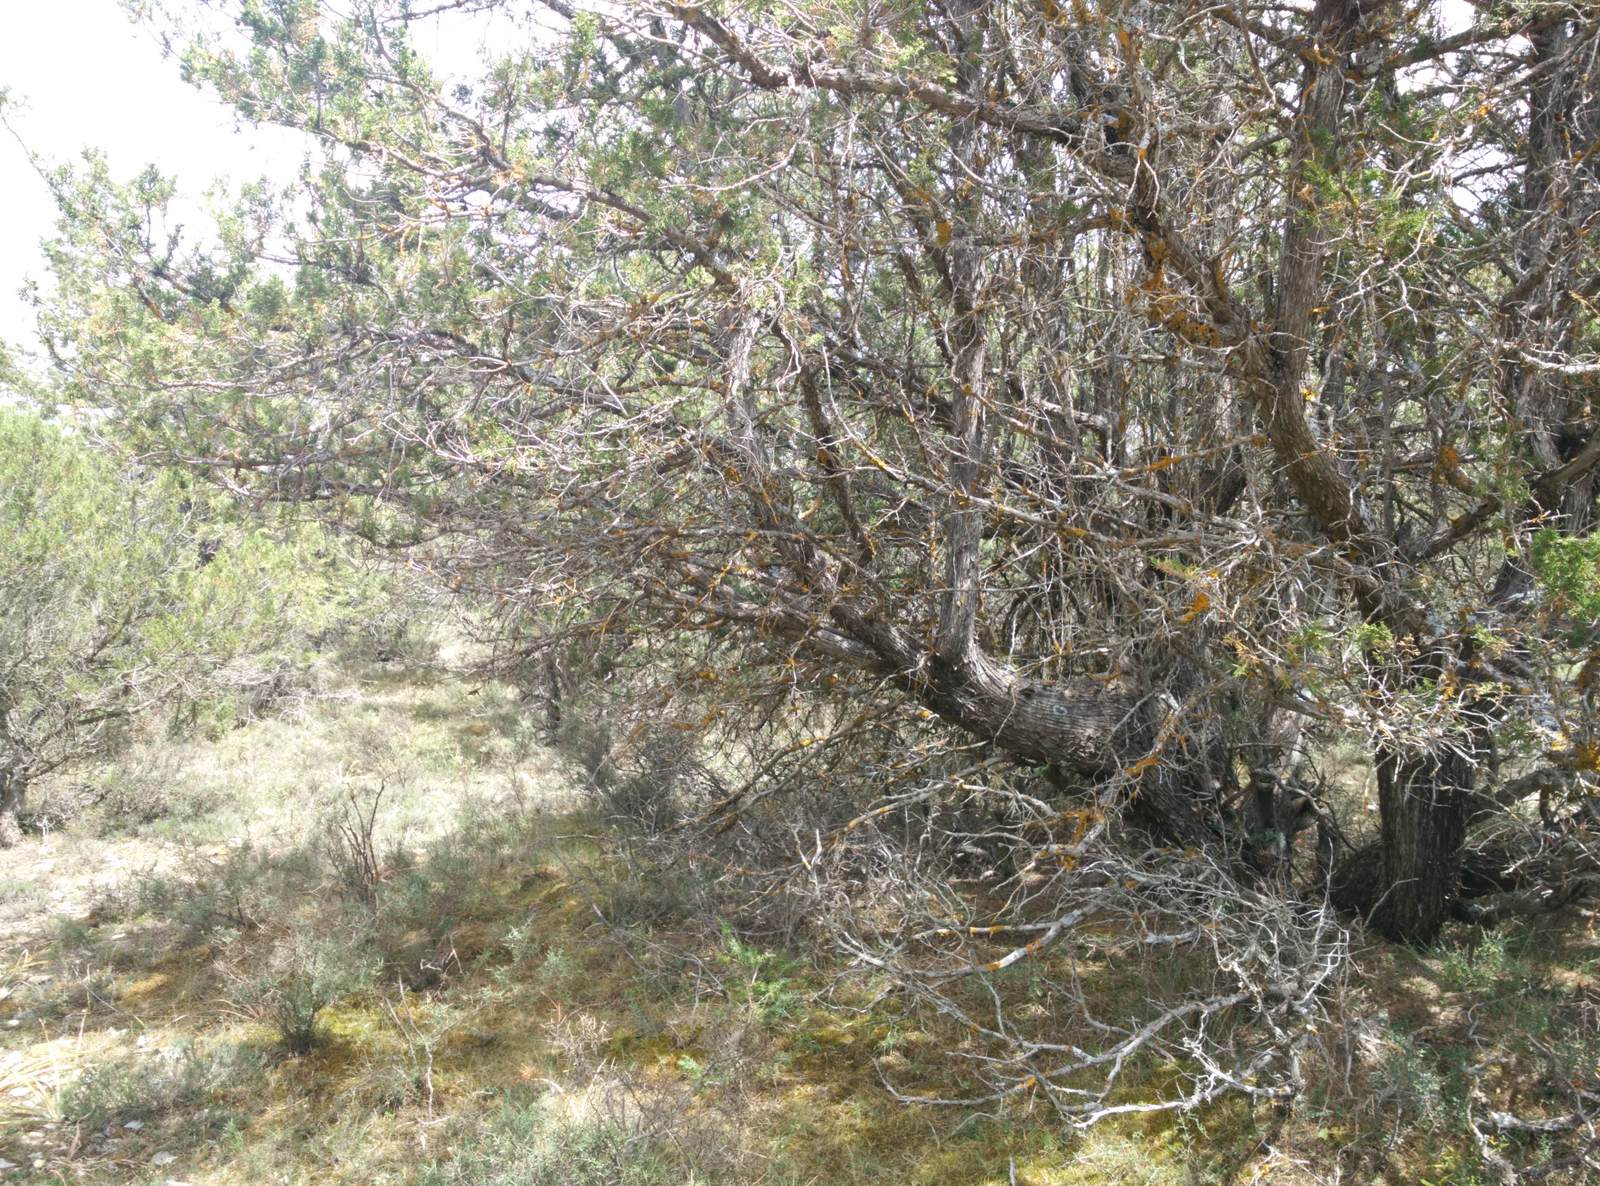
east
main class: Woodland
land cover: Other coniferous woodland
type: coniferous forest of the mediterranean region
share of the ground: 50 - 75 %
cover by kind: coniferous forest trees 65 %, unconsolidated bare surface 20 %, shrubs 15 %
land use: Semi-natural and natural areas not in use
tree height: > 5 m
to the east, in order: Other coniferous woodland
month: July
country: ES
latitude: 40.9989
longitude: -2.0684
